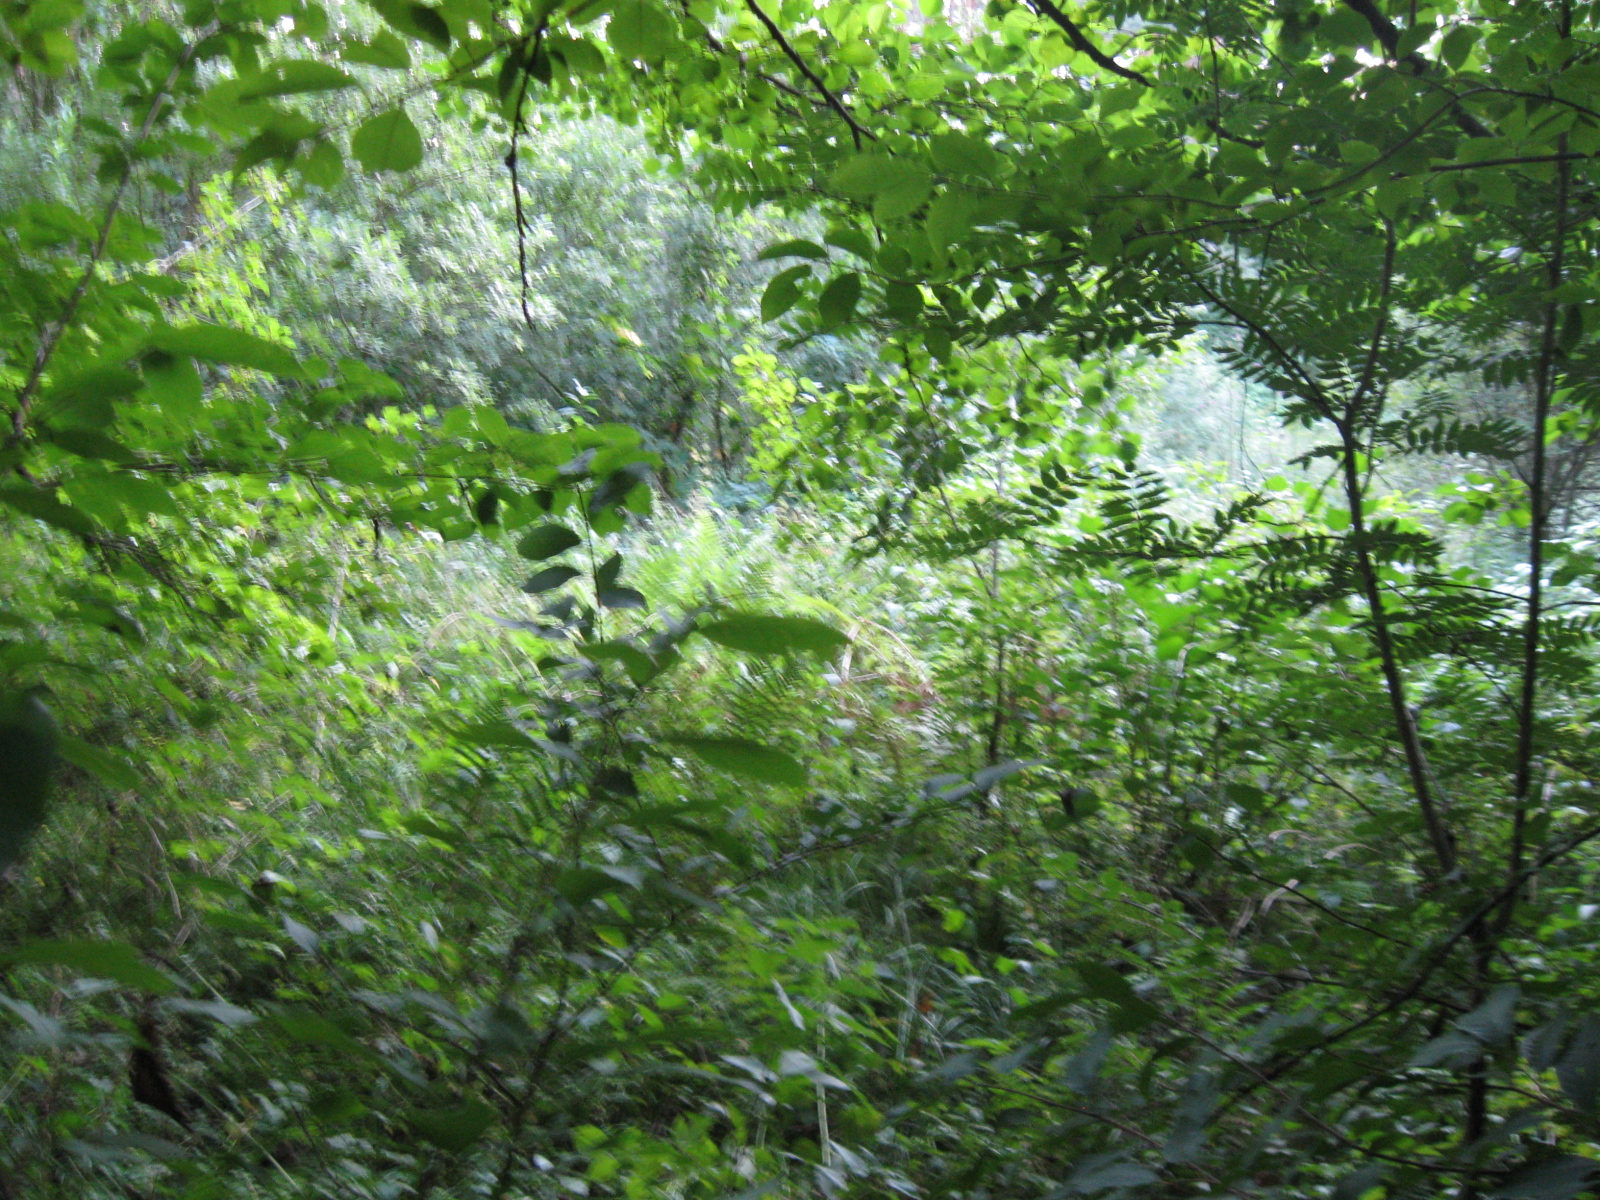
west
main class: Woodland
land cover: Broadleaved woodland
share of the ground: > 75 %
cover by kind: broadleaved forest trees 90 %, shrubs 5 %, herbaceous plants 5 %
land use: Forestry
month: July
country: LT
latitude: 54.3847
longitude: 24.3744
